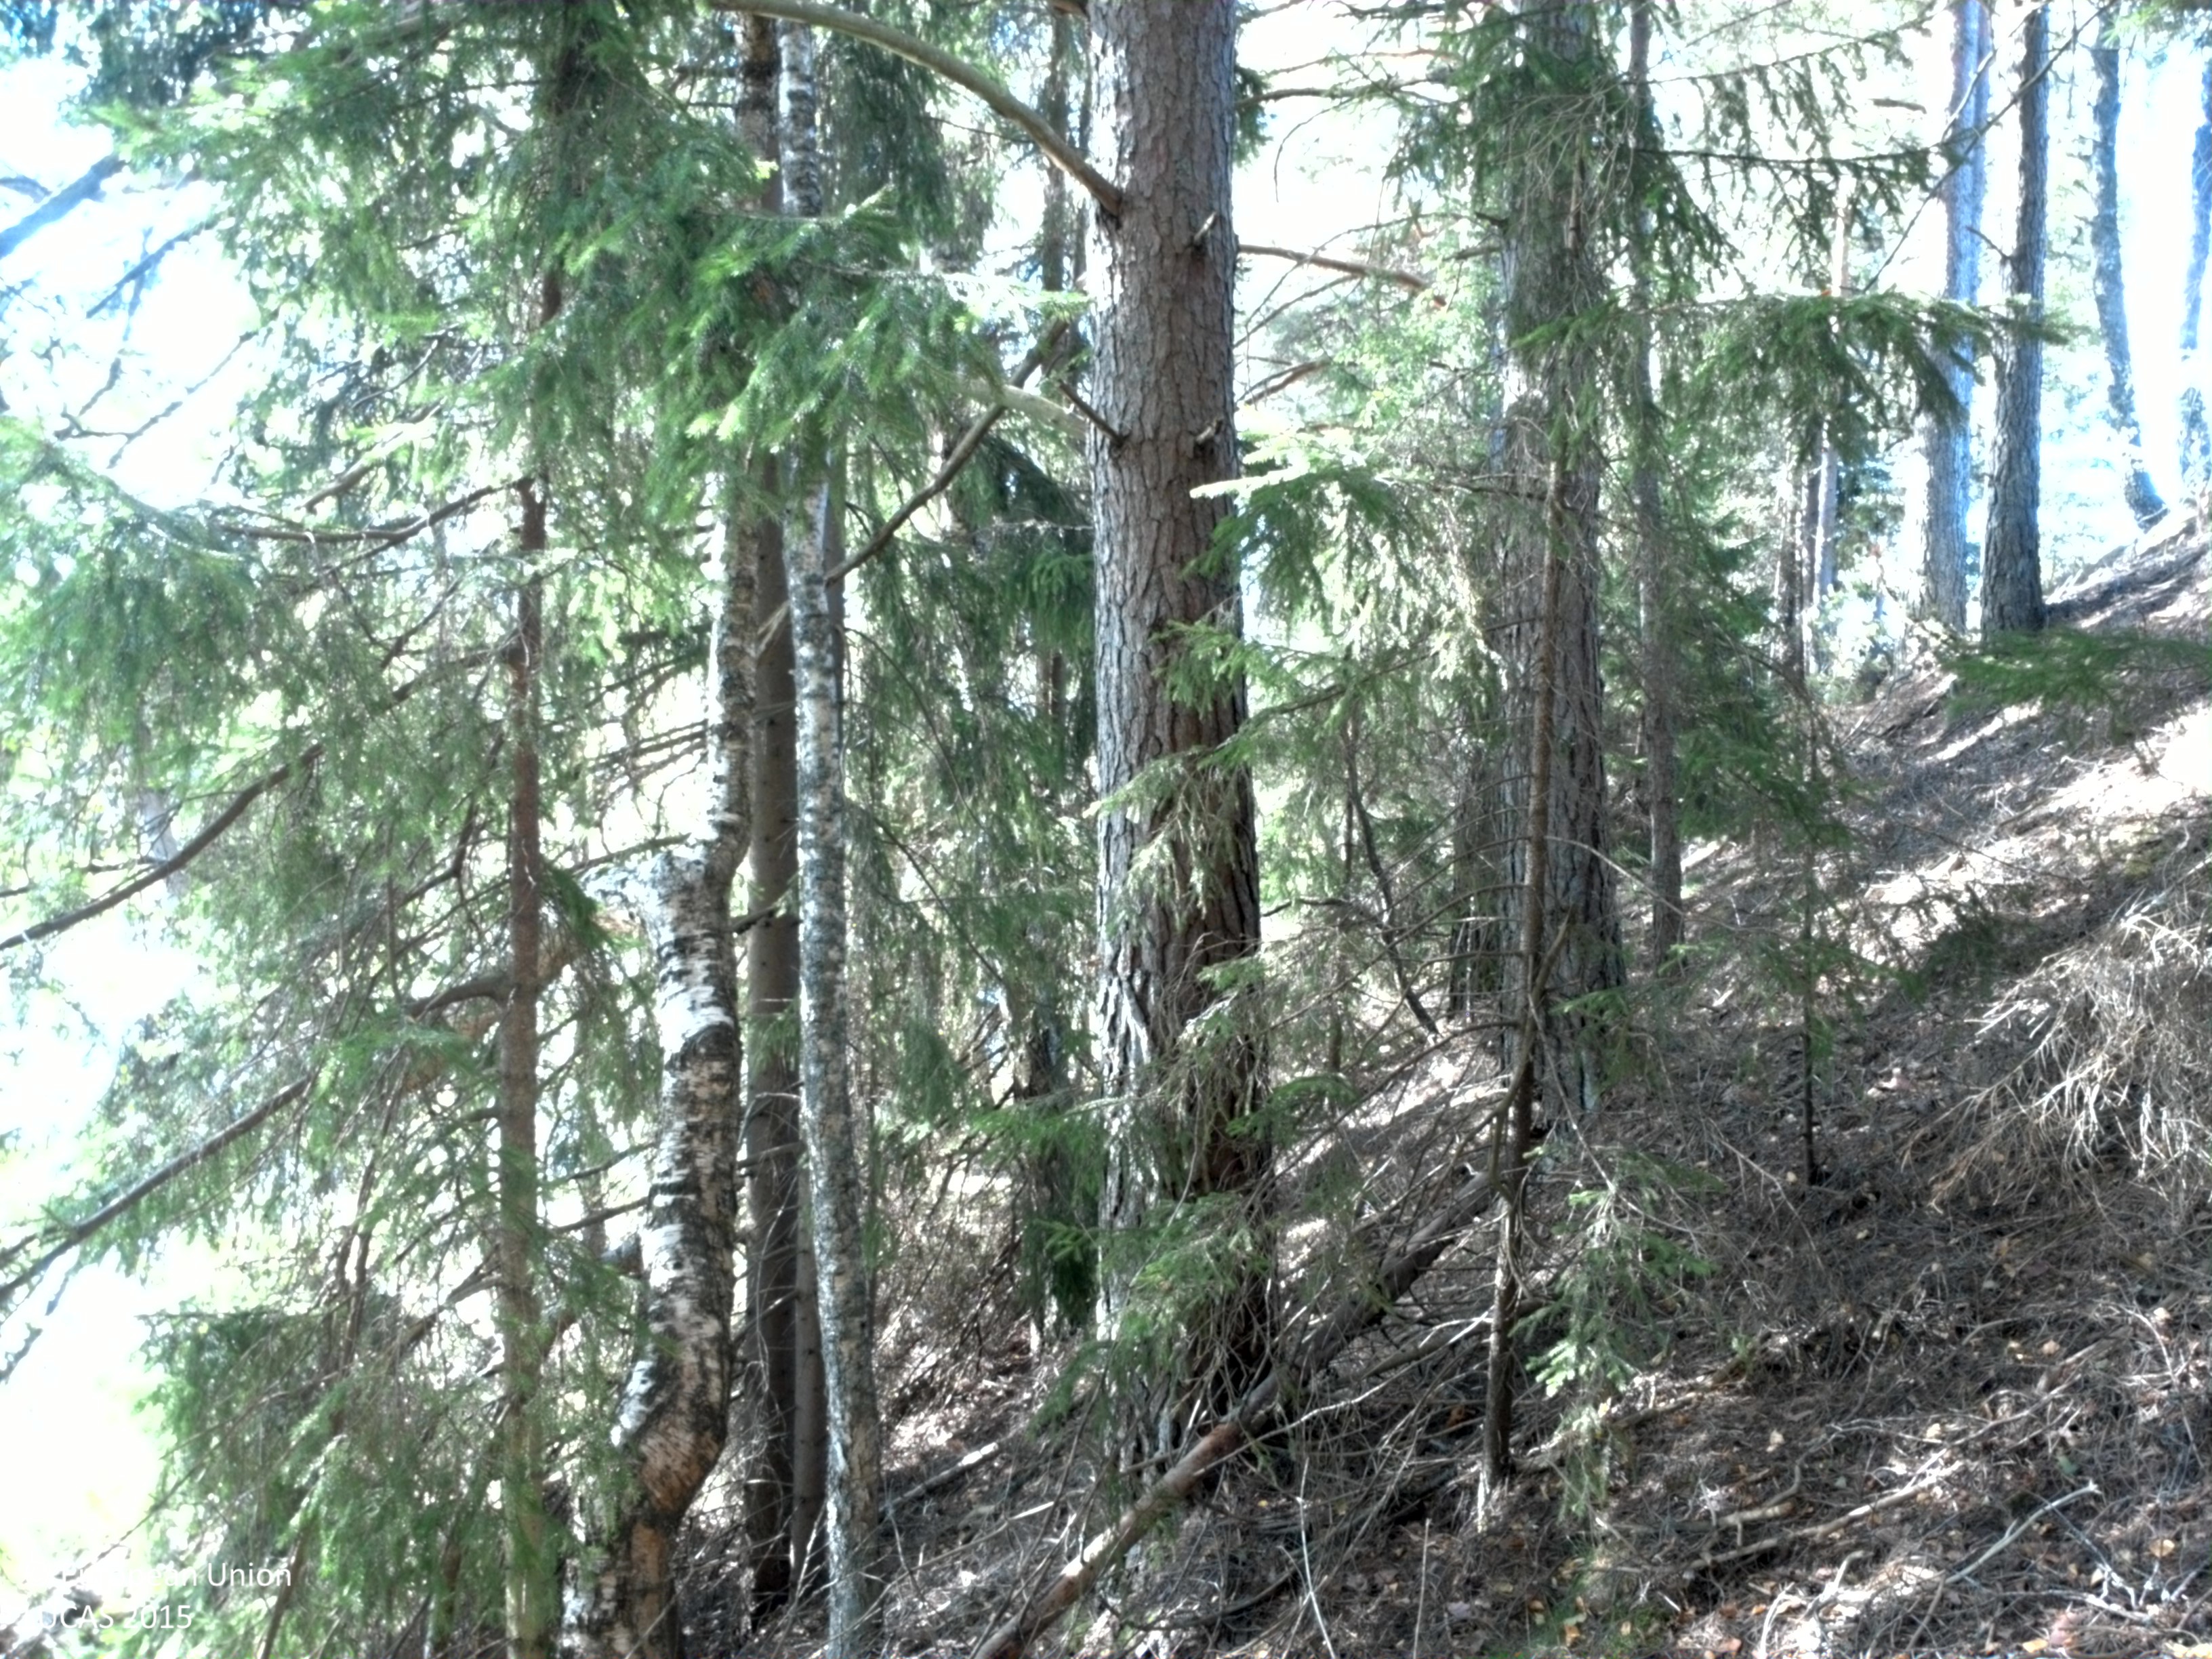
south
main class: Woodland
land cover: Pine dominated coniferous woodland
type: boreal forest
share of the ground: 50 - 75 %
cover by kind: coniferous forest trees 60 %, lichens and mosses 20 %, consolidated bare surface 10 %, broadleaved forest trees 5 %, herbaceous plants 5 %
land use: Amenities, museums, leisure
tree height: > 5 m
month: August
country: SE
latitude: 59.5082
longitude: 13.4373
